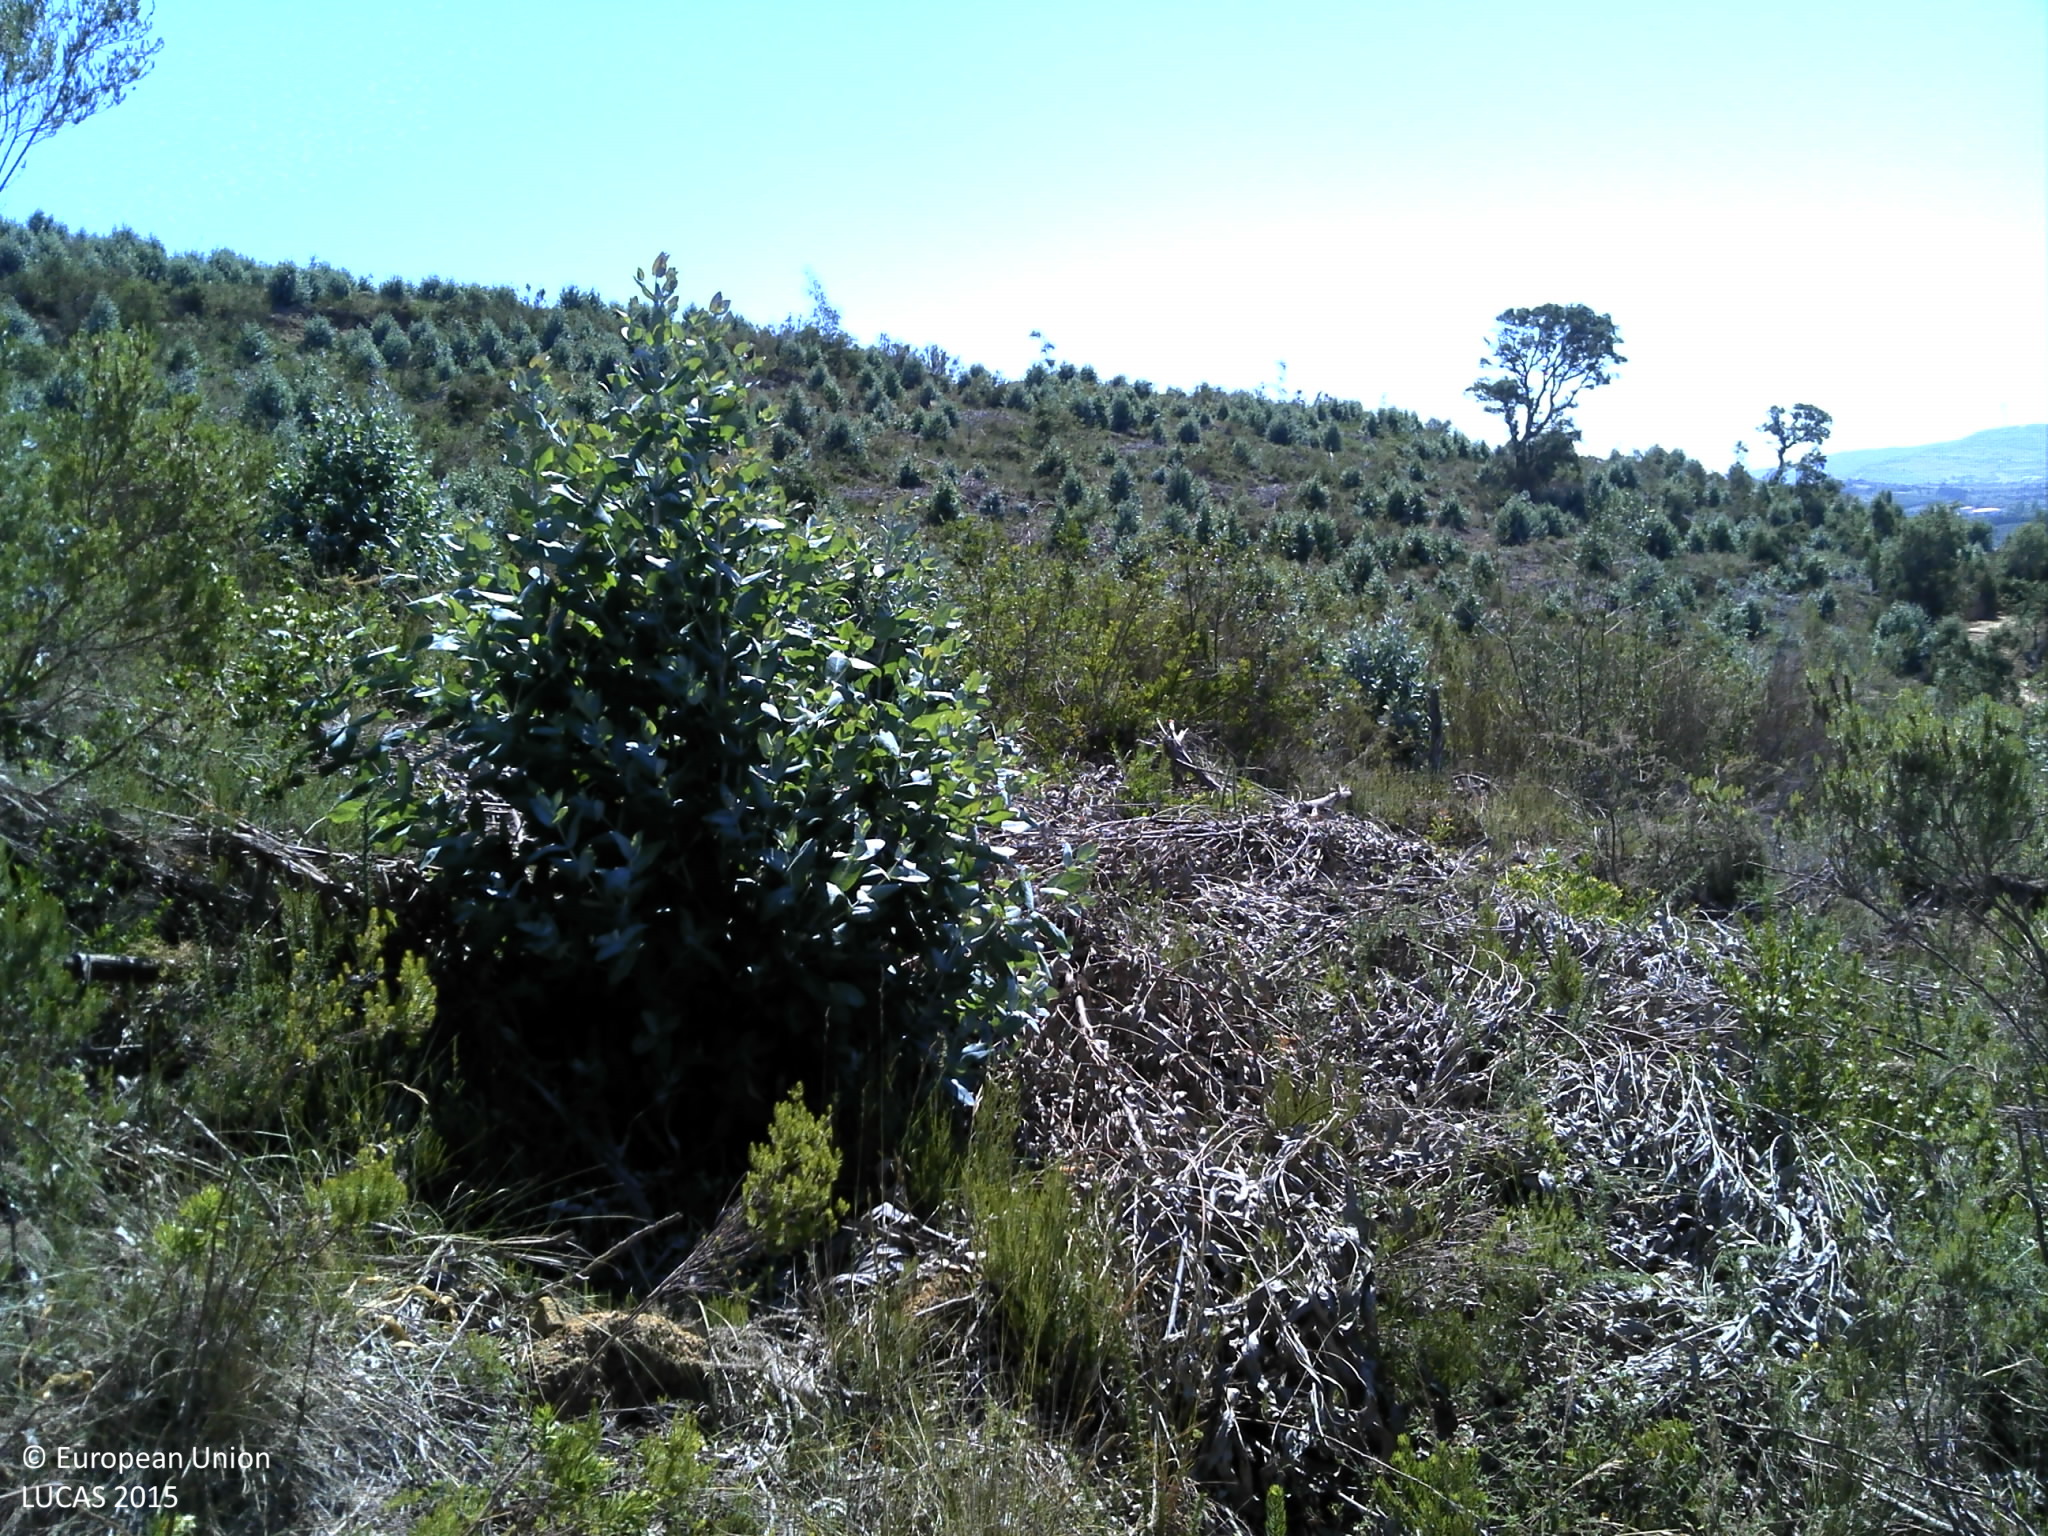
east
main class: Woodland
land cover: Broadleaved woodland
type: exotic forest
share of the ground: 10 - 25 %
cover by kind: shrubs 50 %, broadleaved forest trees 25 %, unconsolidated bare surface 25 %
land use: Forestry
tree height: < 5 m
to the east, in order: Broadleaved woodland
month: June
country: PT
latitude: 39.0140
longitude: -9.2202
